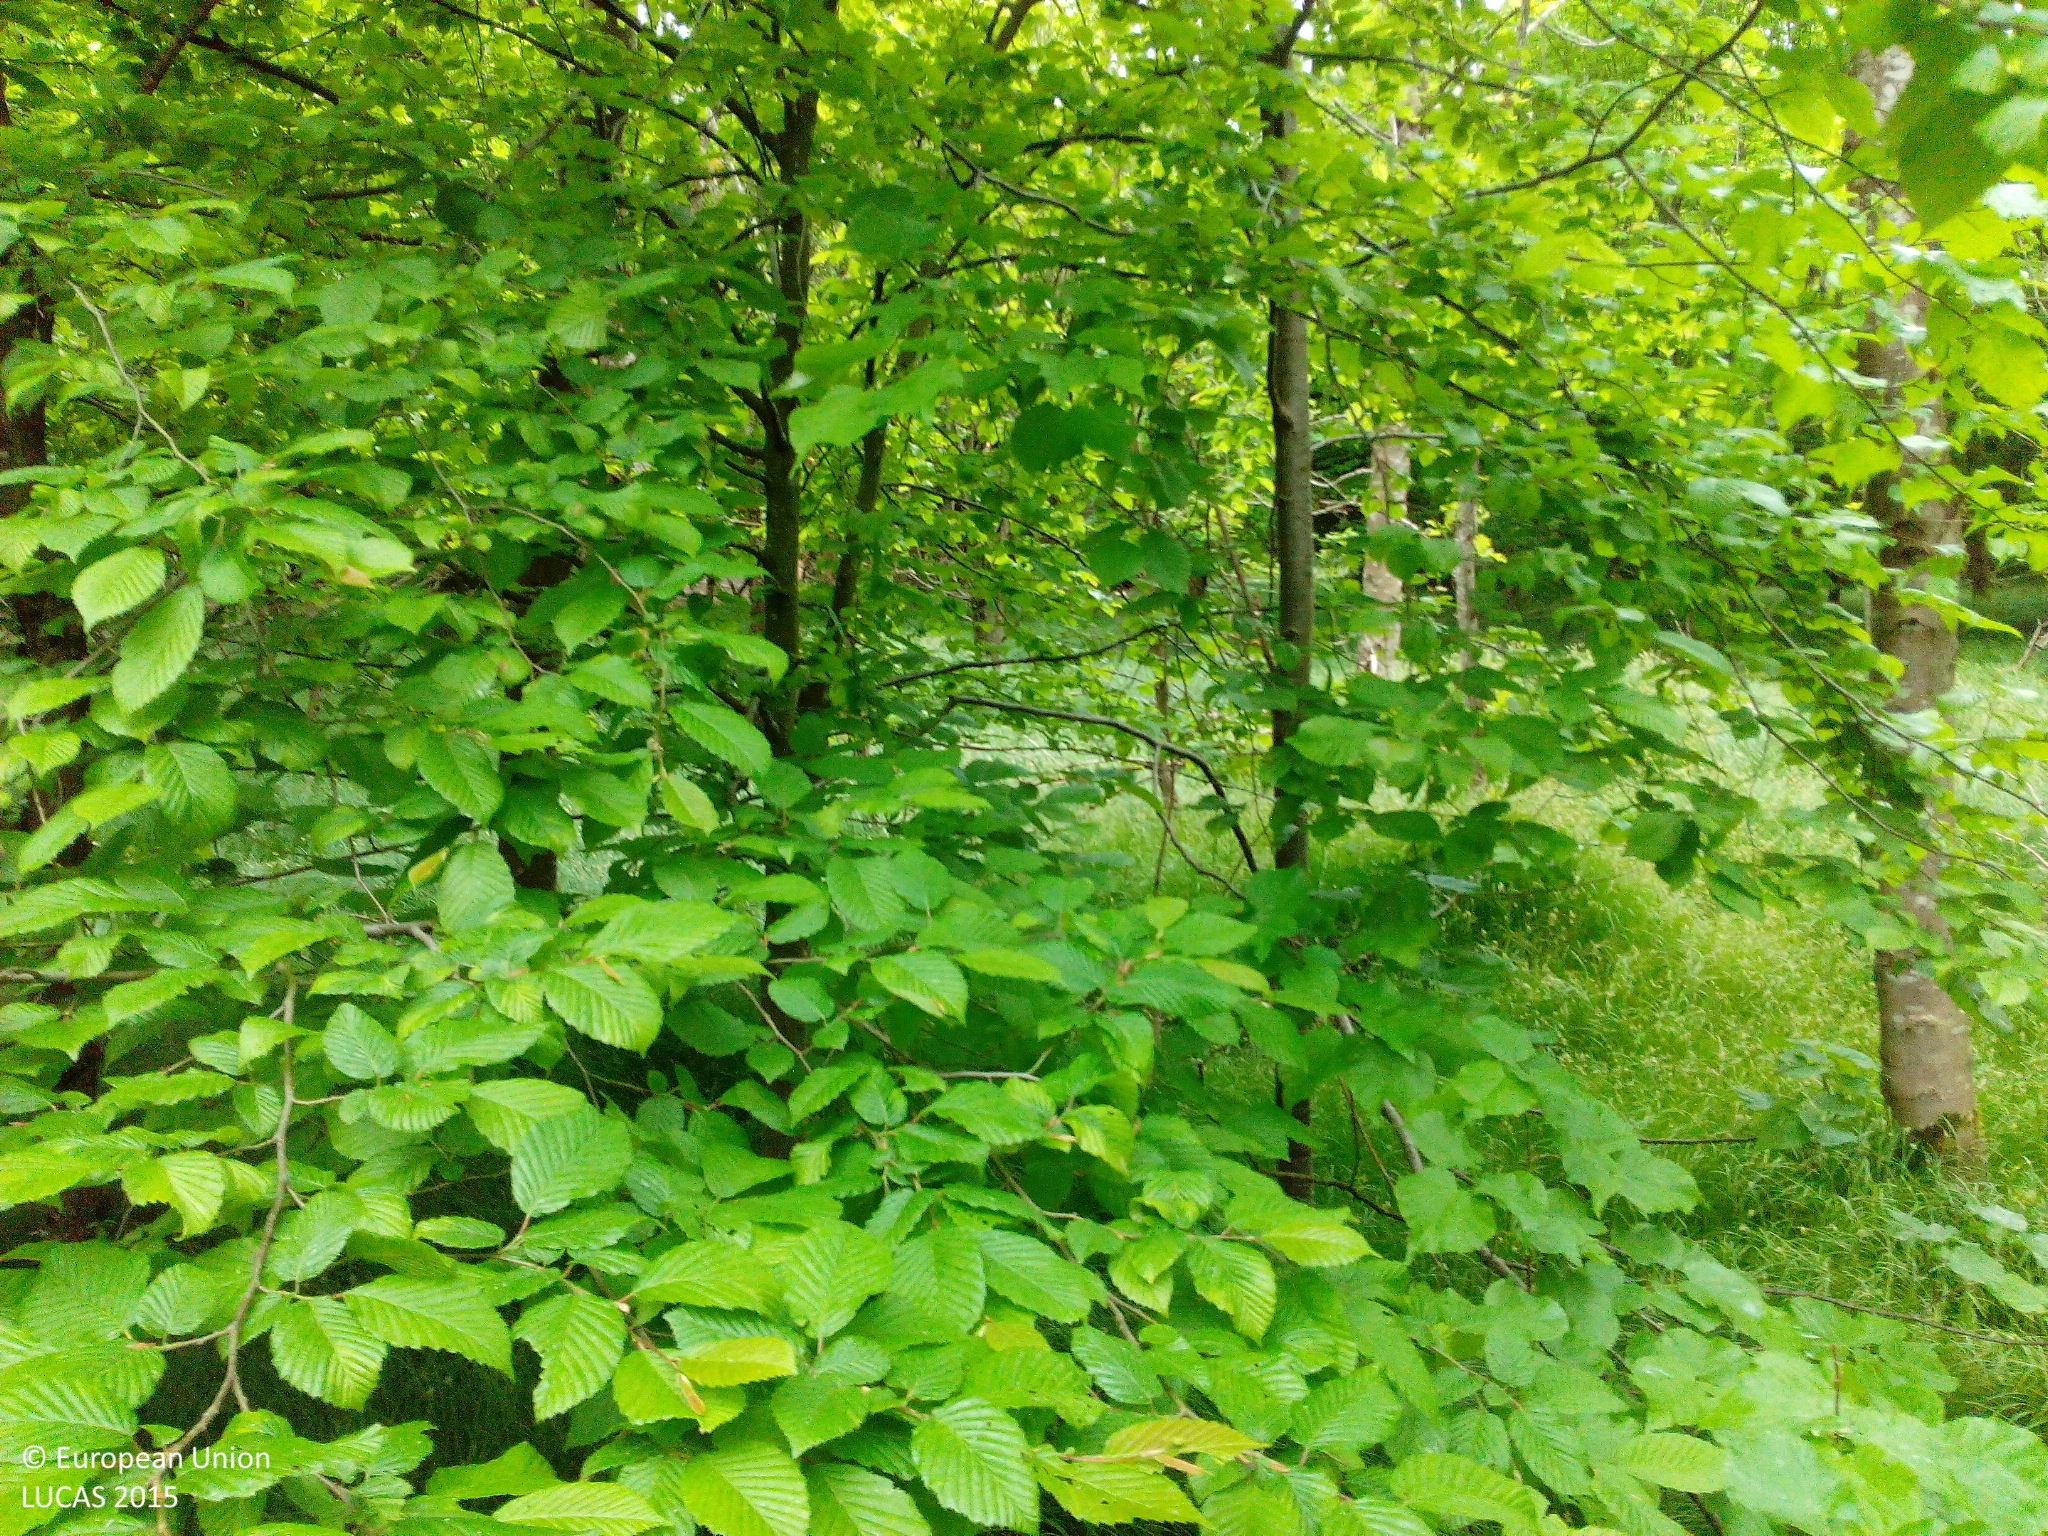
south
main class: Woodland
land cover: Broadleaved woodland
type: mesophytic deciduous forest
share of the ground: > 75 %
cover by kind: broadleaved forest trees 75 %, herbaceous plants 20 %, coniferous forest trees 5 %
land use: Forestry
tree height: > 5 m
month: May
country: DE
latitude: 48.0436
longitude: 9.9330
